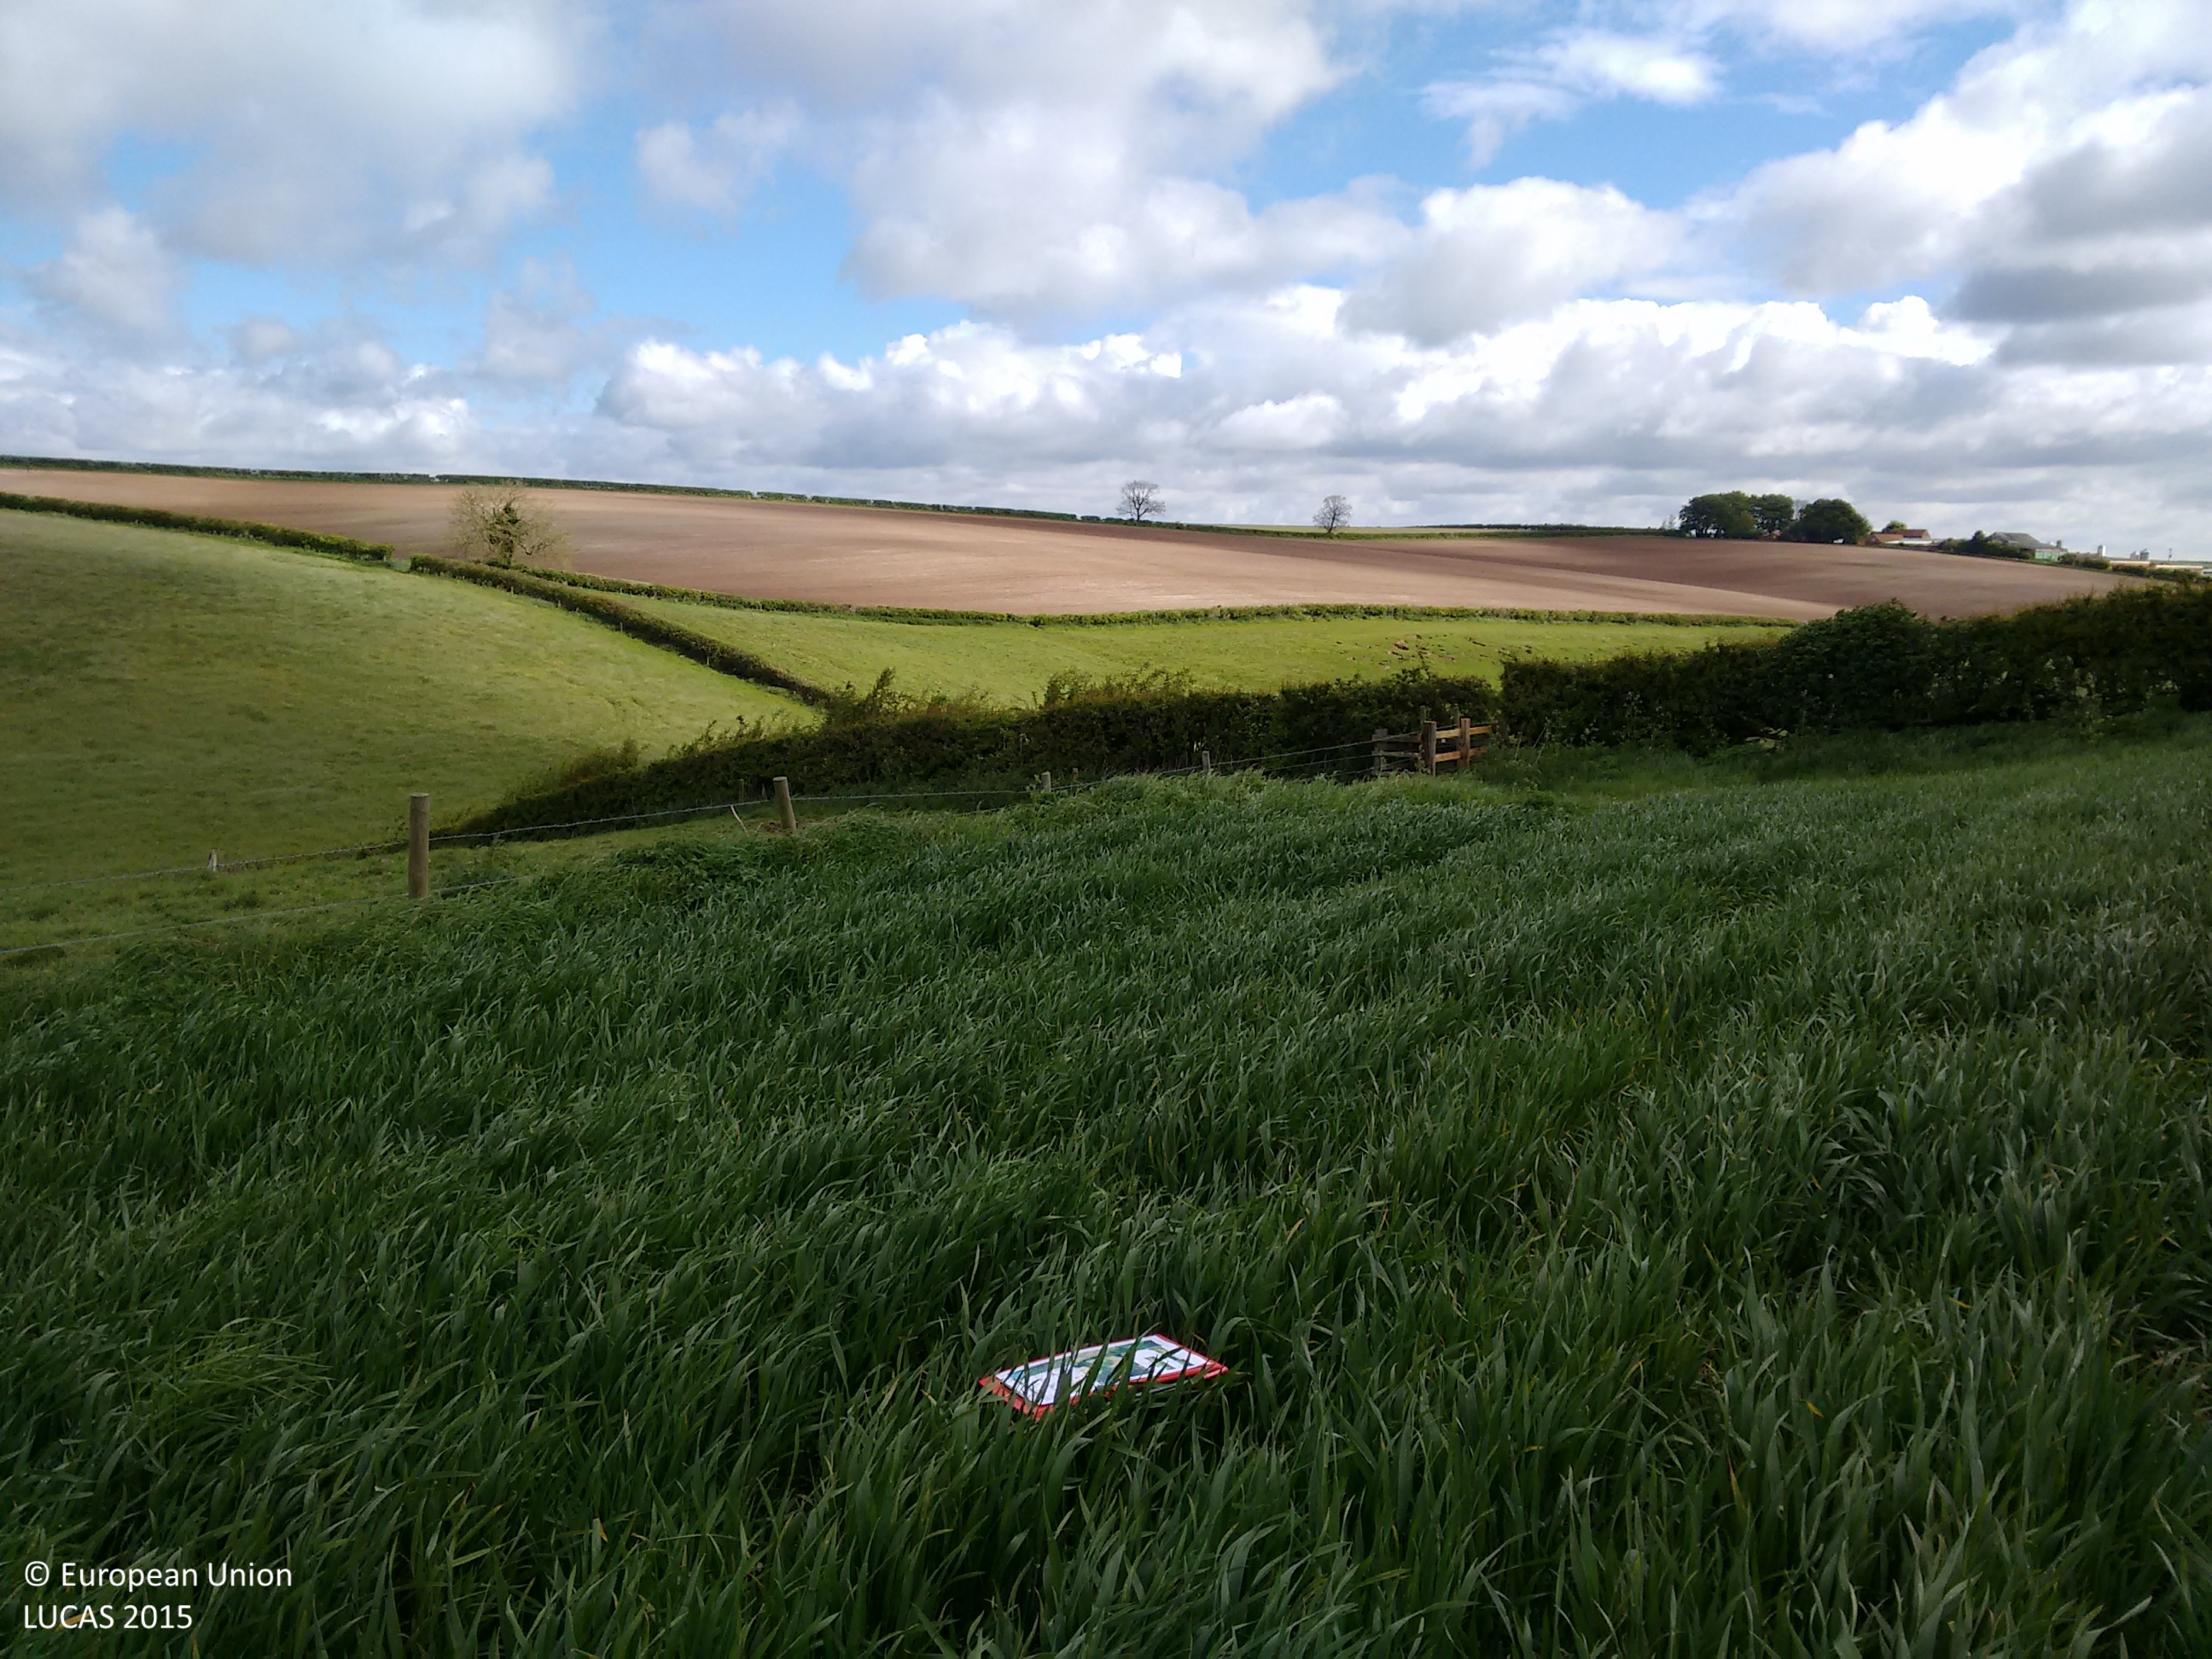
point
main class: Cropland
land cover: Common wheat
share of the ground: > 75 %
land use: Agriculture (excluding fallow land and kitchen gardens)
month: May
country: GB
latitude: 53.3985
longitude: -0.0638
